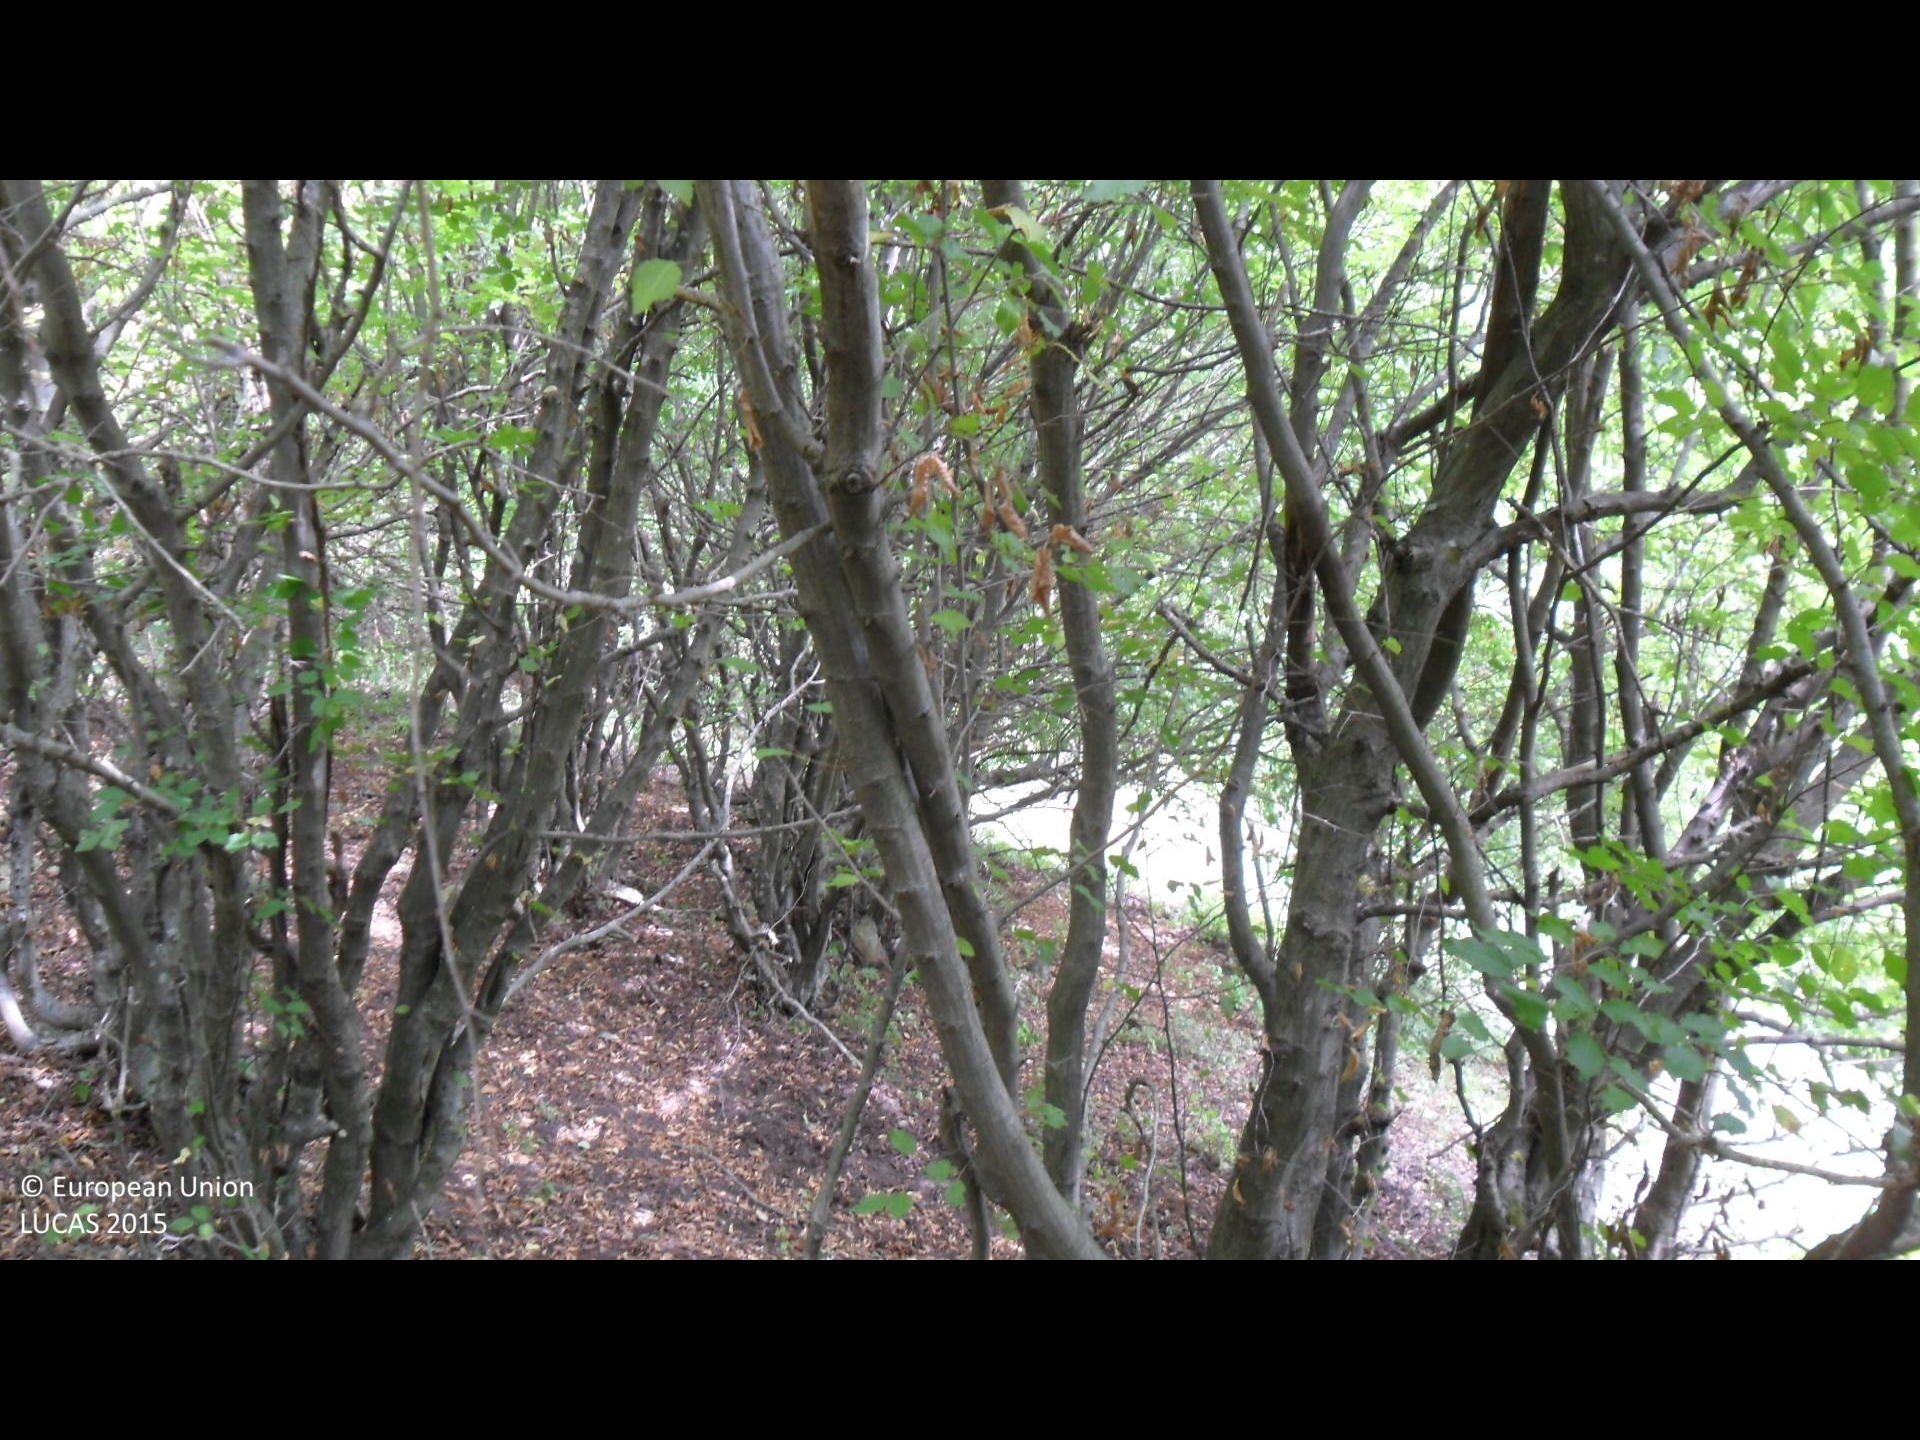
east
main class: Woodland
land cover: Broadleaved woodland
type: mesophytic deciduous forest
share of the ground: 50 - 75 %
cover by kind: broadleaved forest trees 100 %
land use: Forestry
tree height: > 5 m
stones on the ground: 10 - 25 %
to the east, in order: Broadleaved woodland; Shrubland with sparse tree cover; Grassland with sparse tree/shrub cover; Shrubland with sparse tree cover; Grassland with sparse tree/shrub cover; Shrubland with sparse tree cover; Grassland with sparse tree/shrub cover
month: August
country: BG
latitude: 43.5137
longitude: 26.1657
